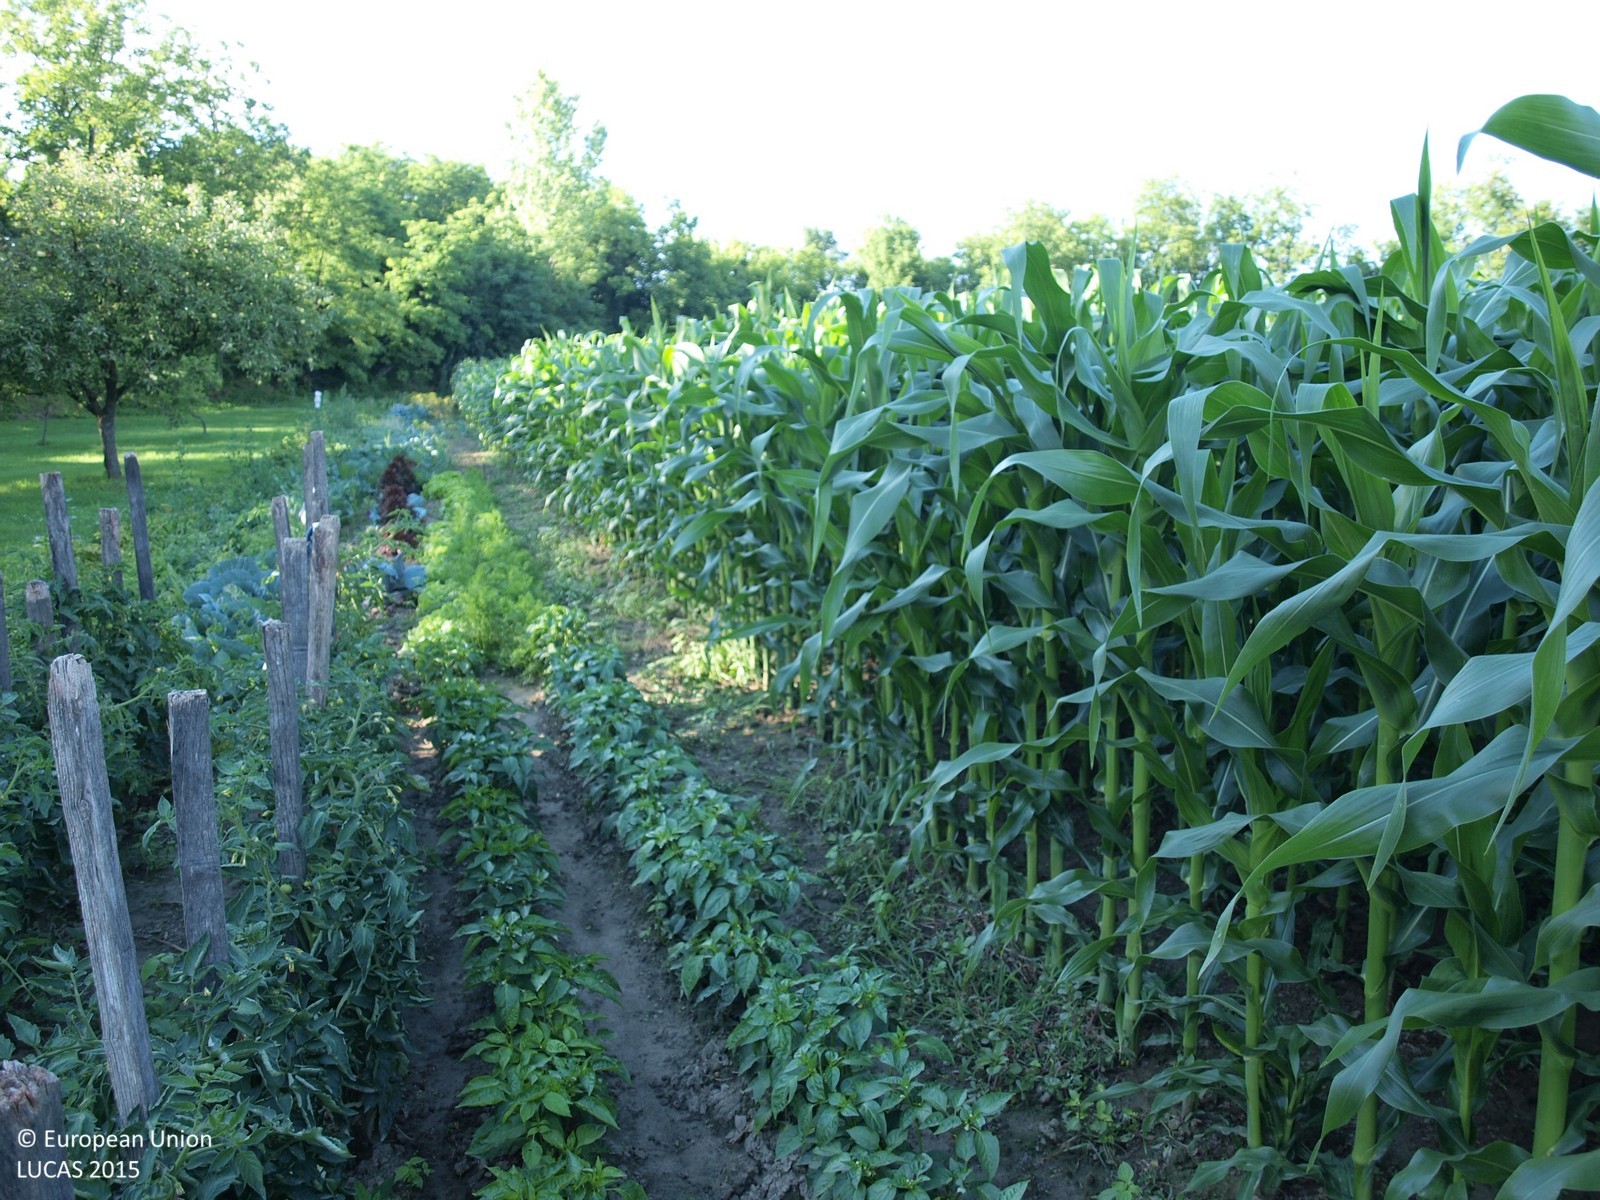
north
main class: Cropland
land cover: Other fresh vegetables
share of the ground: 50 - 75 %
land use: Agriculture (excluding fallow land and kitchen gardens)
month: June
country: HR
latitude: 46.2849
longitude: 16.7114
